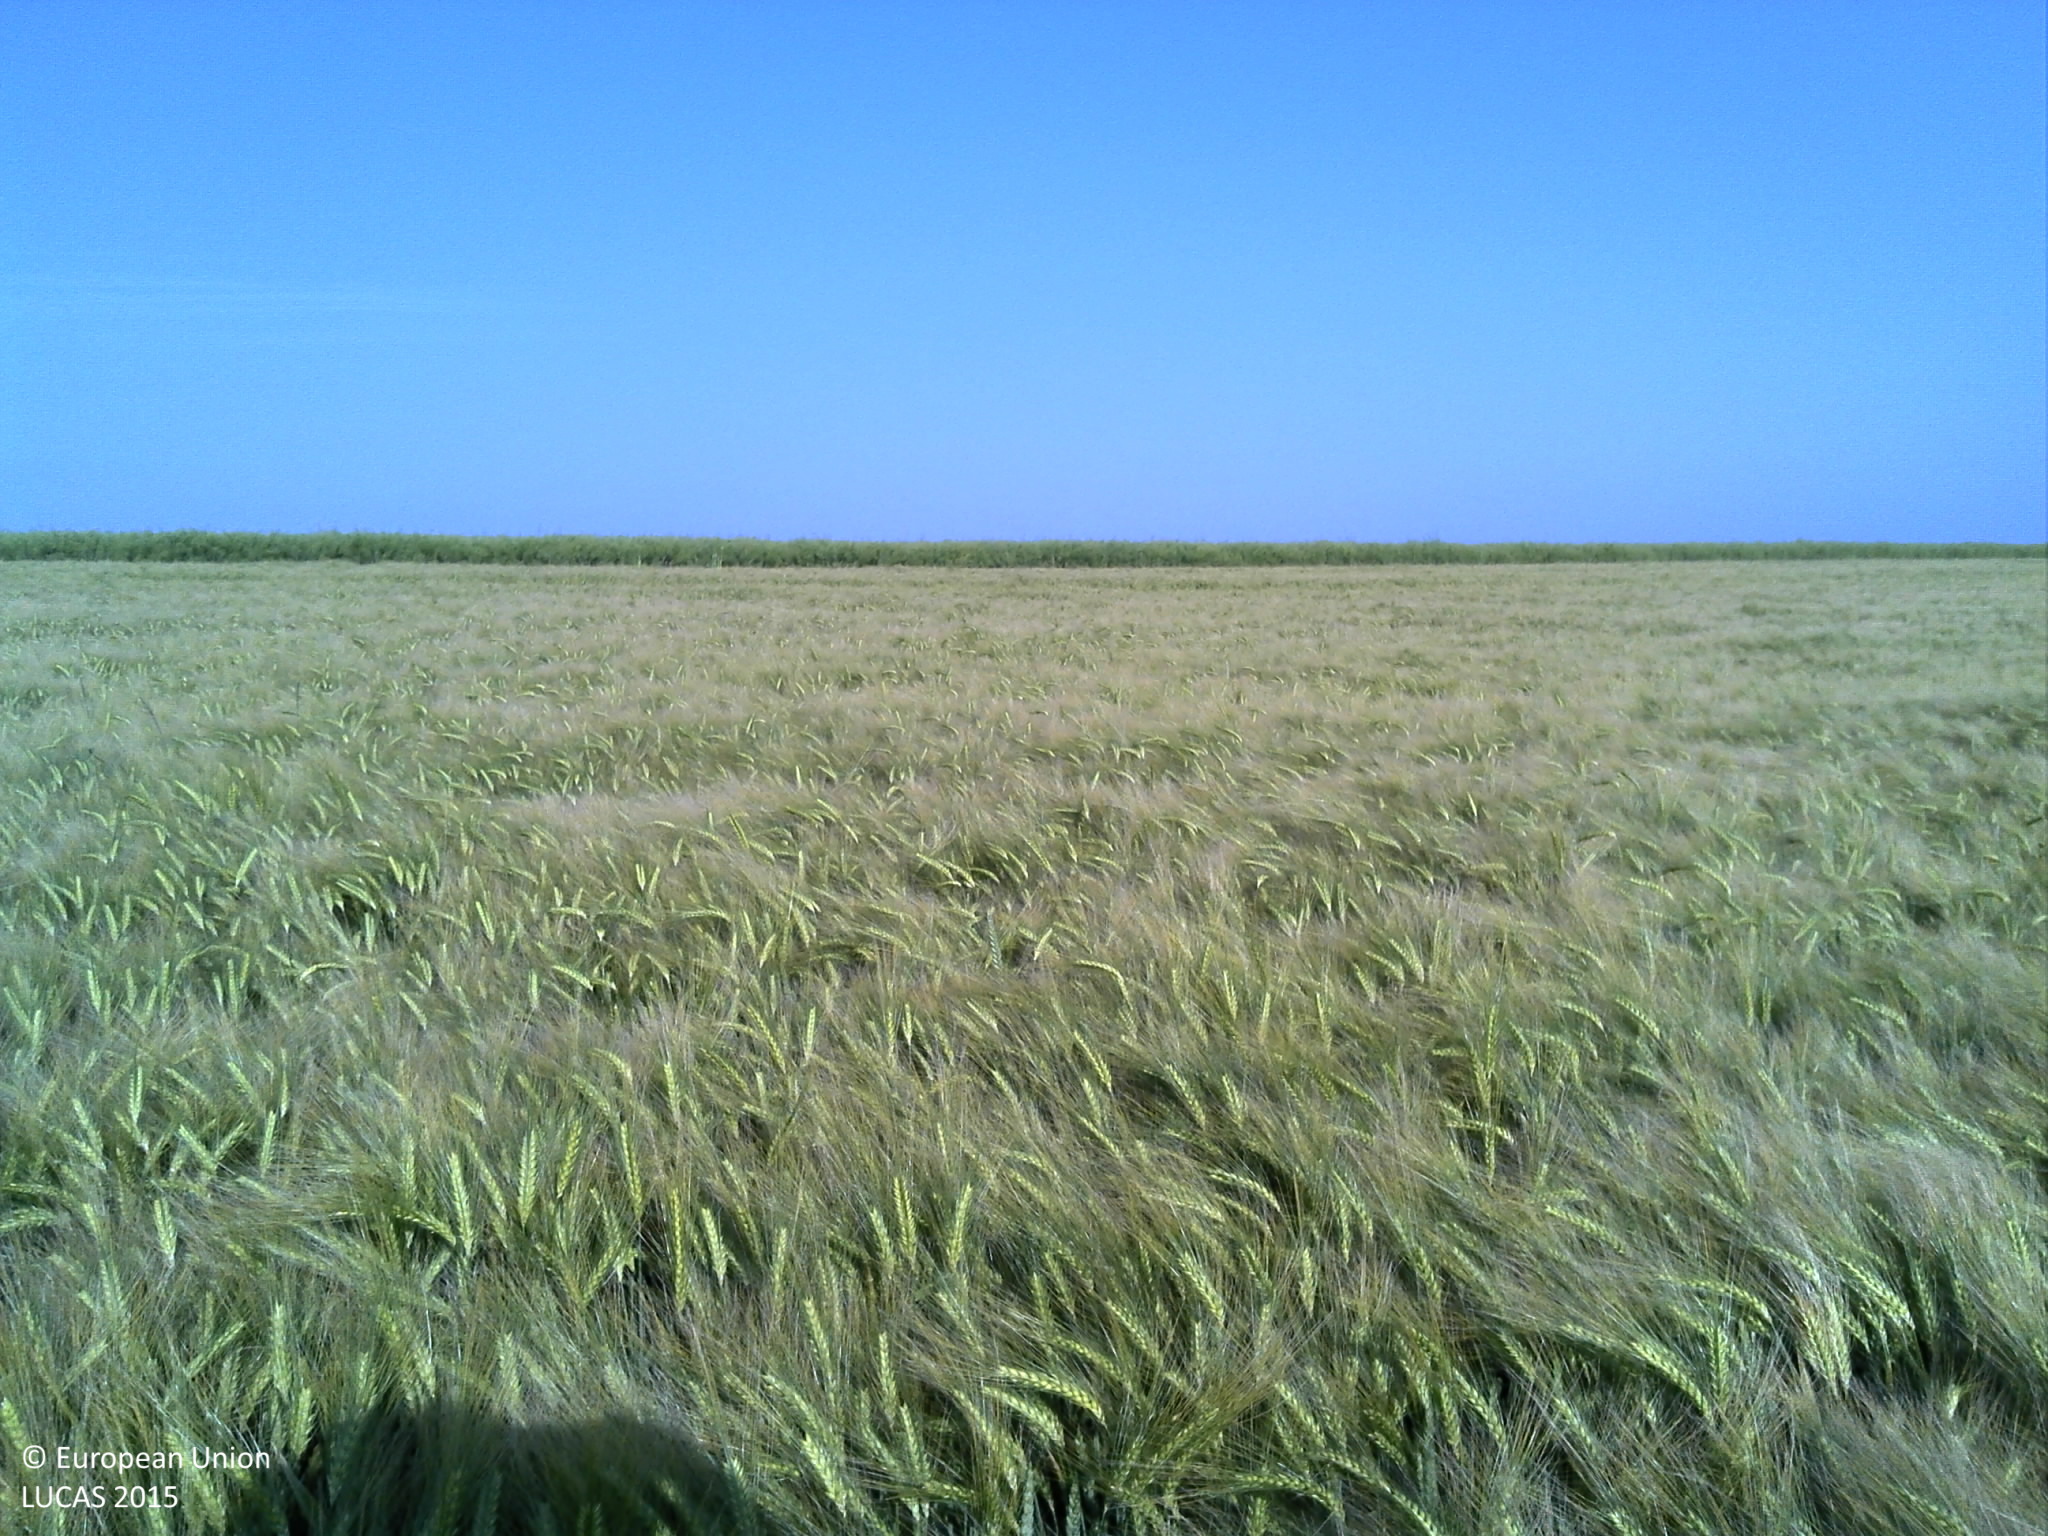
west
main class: Cropland
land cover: Barley
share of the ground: > 75 %
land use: Agriculture (excluding fallow land and kitchen gardens)
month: June
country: FR
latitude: 49.6903
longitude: 1.0927
